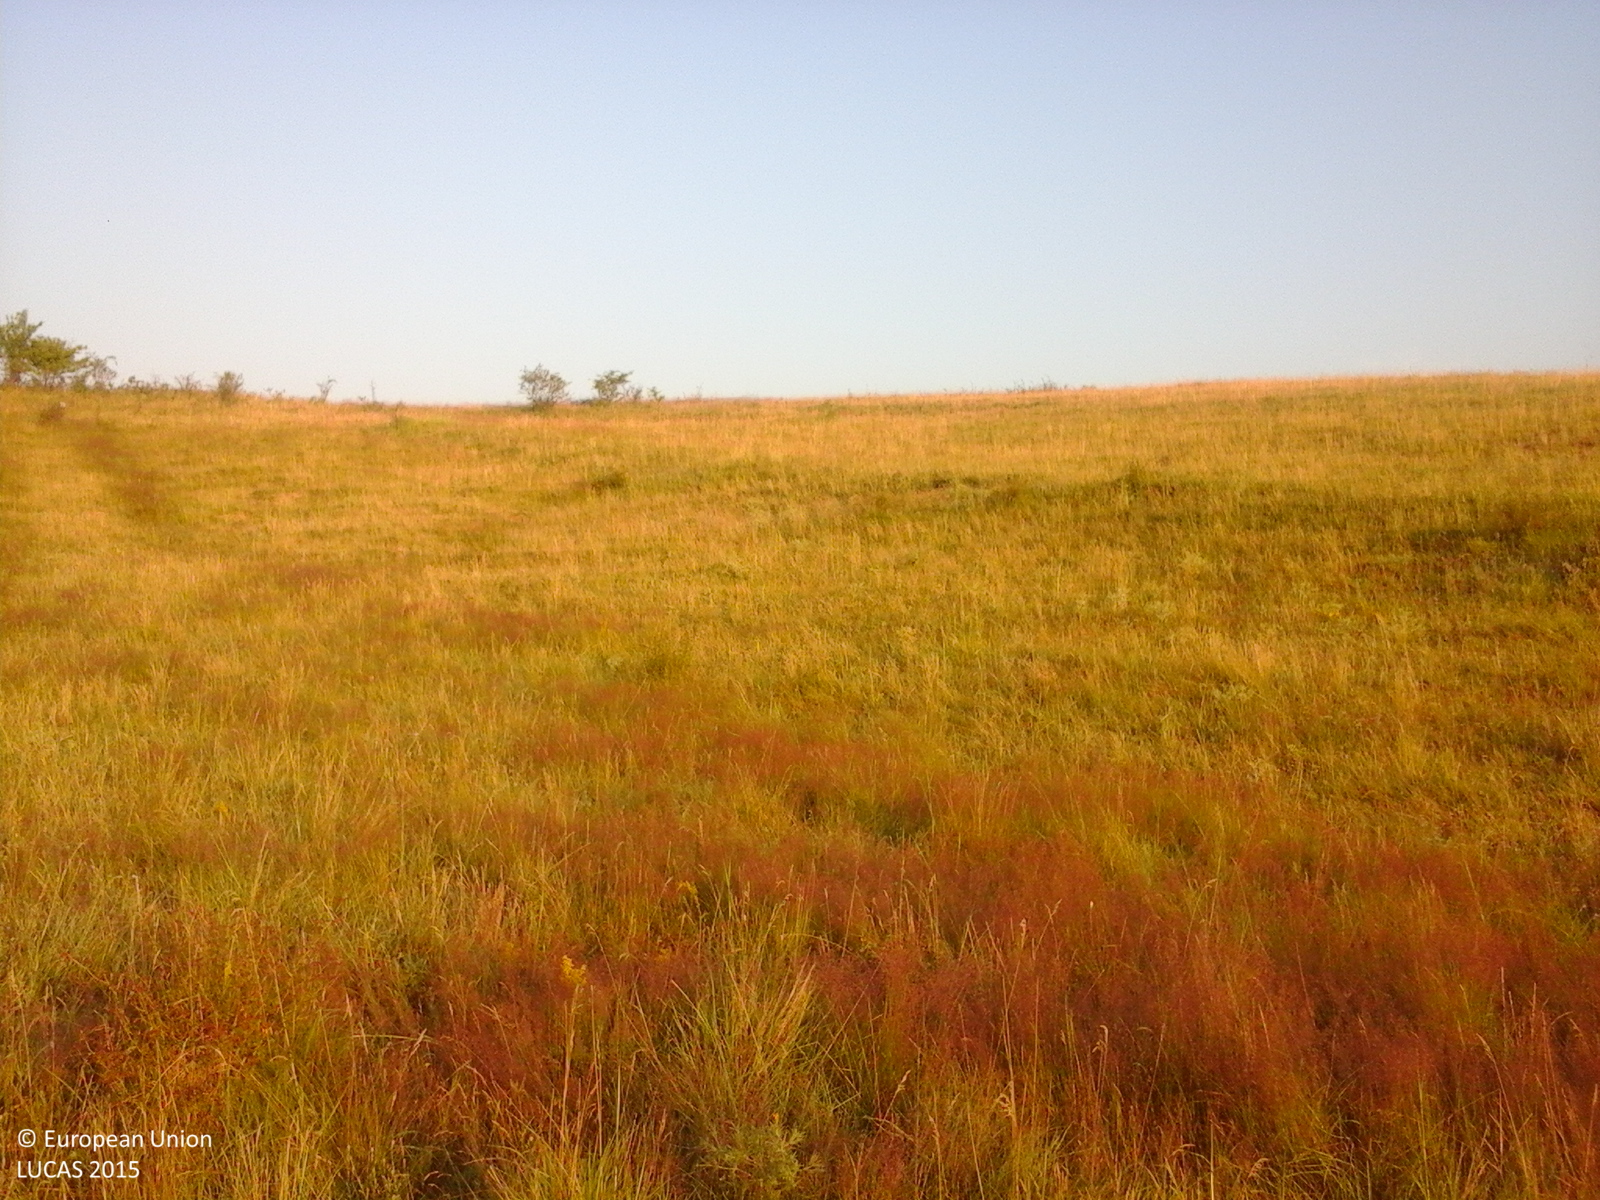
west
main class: Grassland
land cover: Grassland with sparse tree/shrub cover
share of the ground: > 75 %
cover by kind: herbaceous plants 85 %, shrubs 10 %, broadleaved forest trees 5 %
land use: Agriculture (excluding fallow land and kitchen gardens)
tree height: < 5 m
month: July
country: RO
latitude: 44.6141
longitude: 24.7066
